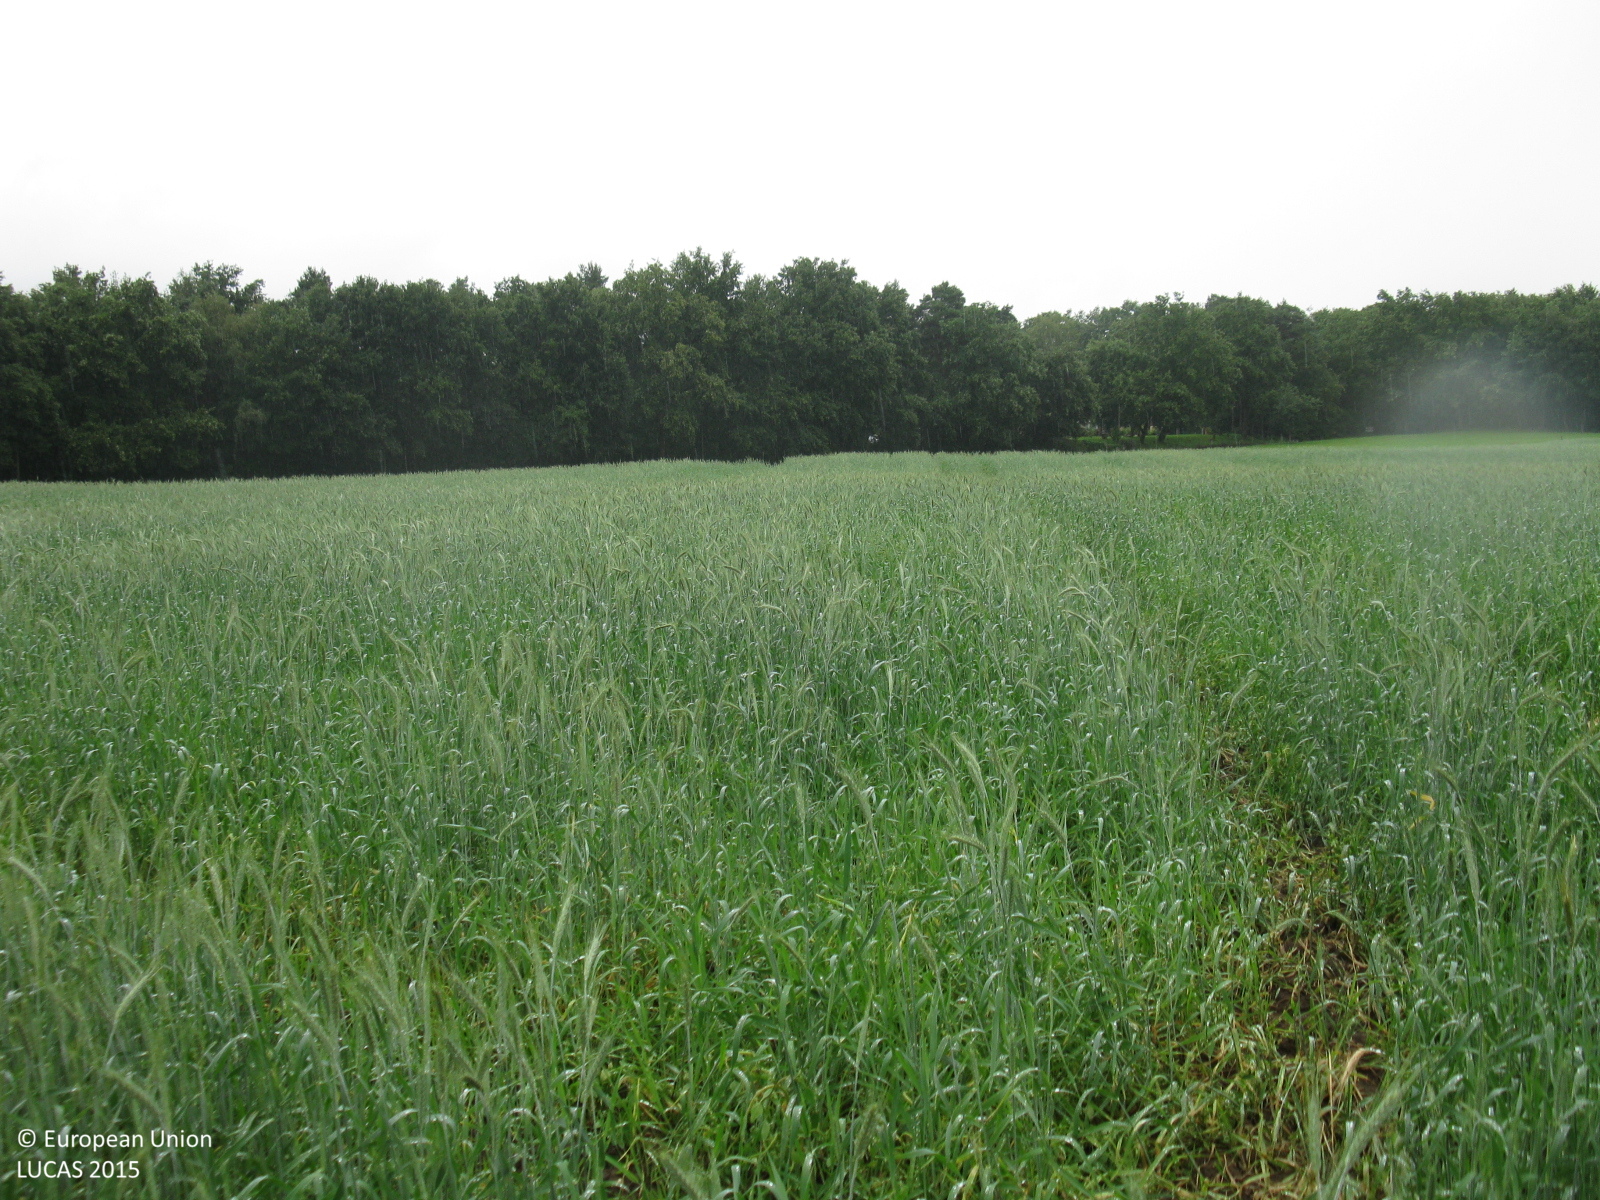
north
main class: Cropland
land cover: Rye
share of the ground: > 75 %
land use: Agriculture (excluding fallow land and kitchen gardens)
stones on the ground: < 10 %
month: August
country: DE
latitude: 51.6907
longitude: 6.9476
